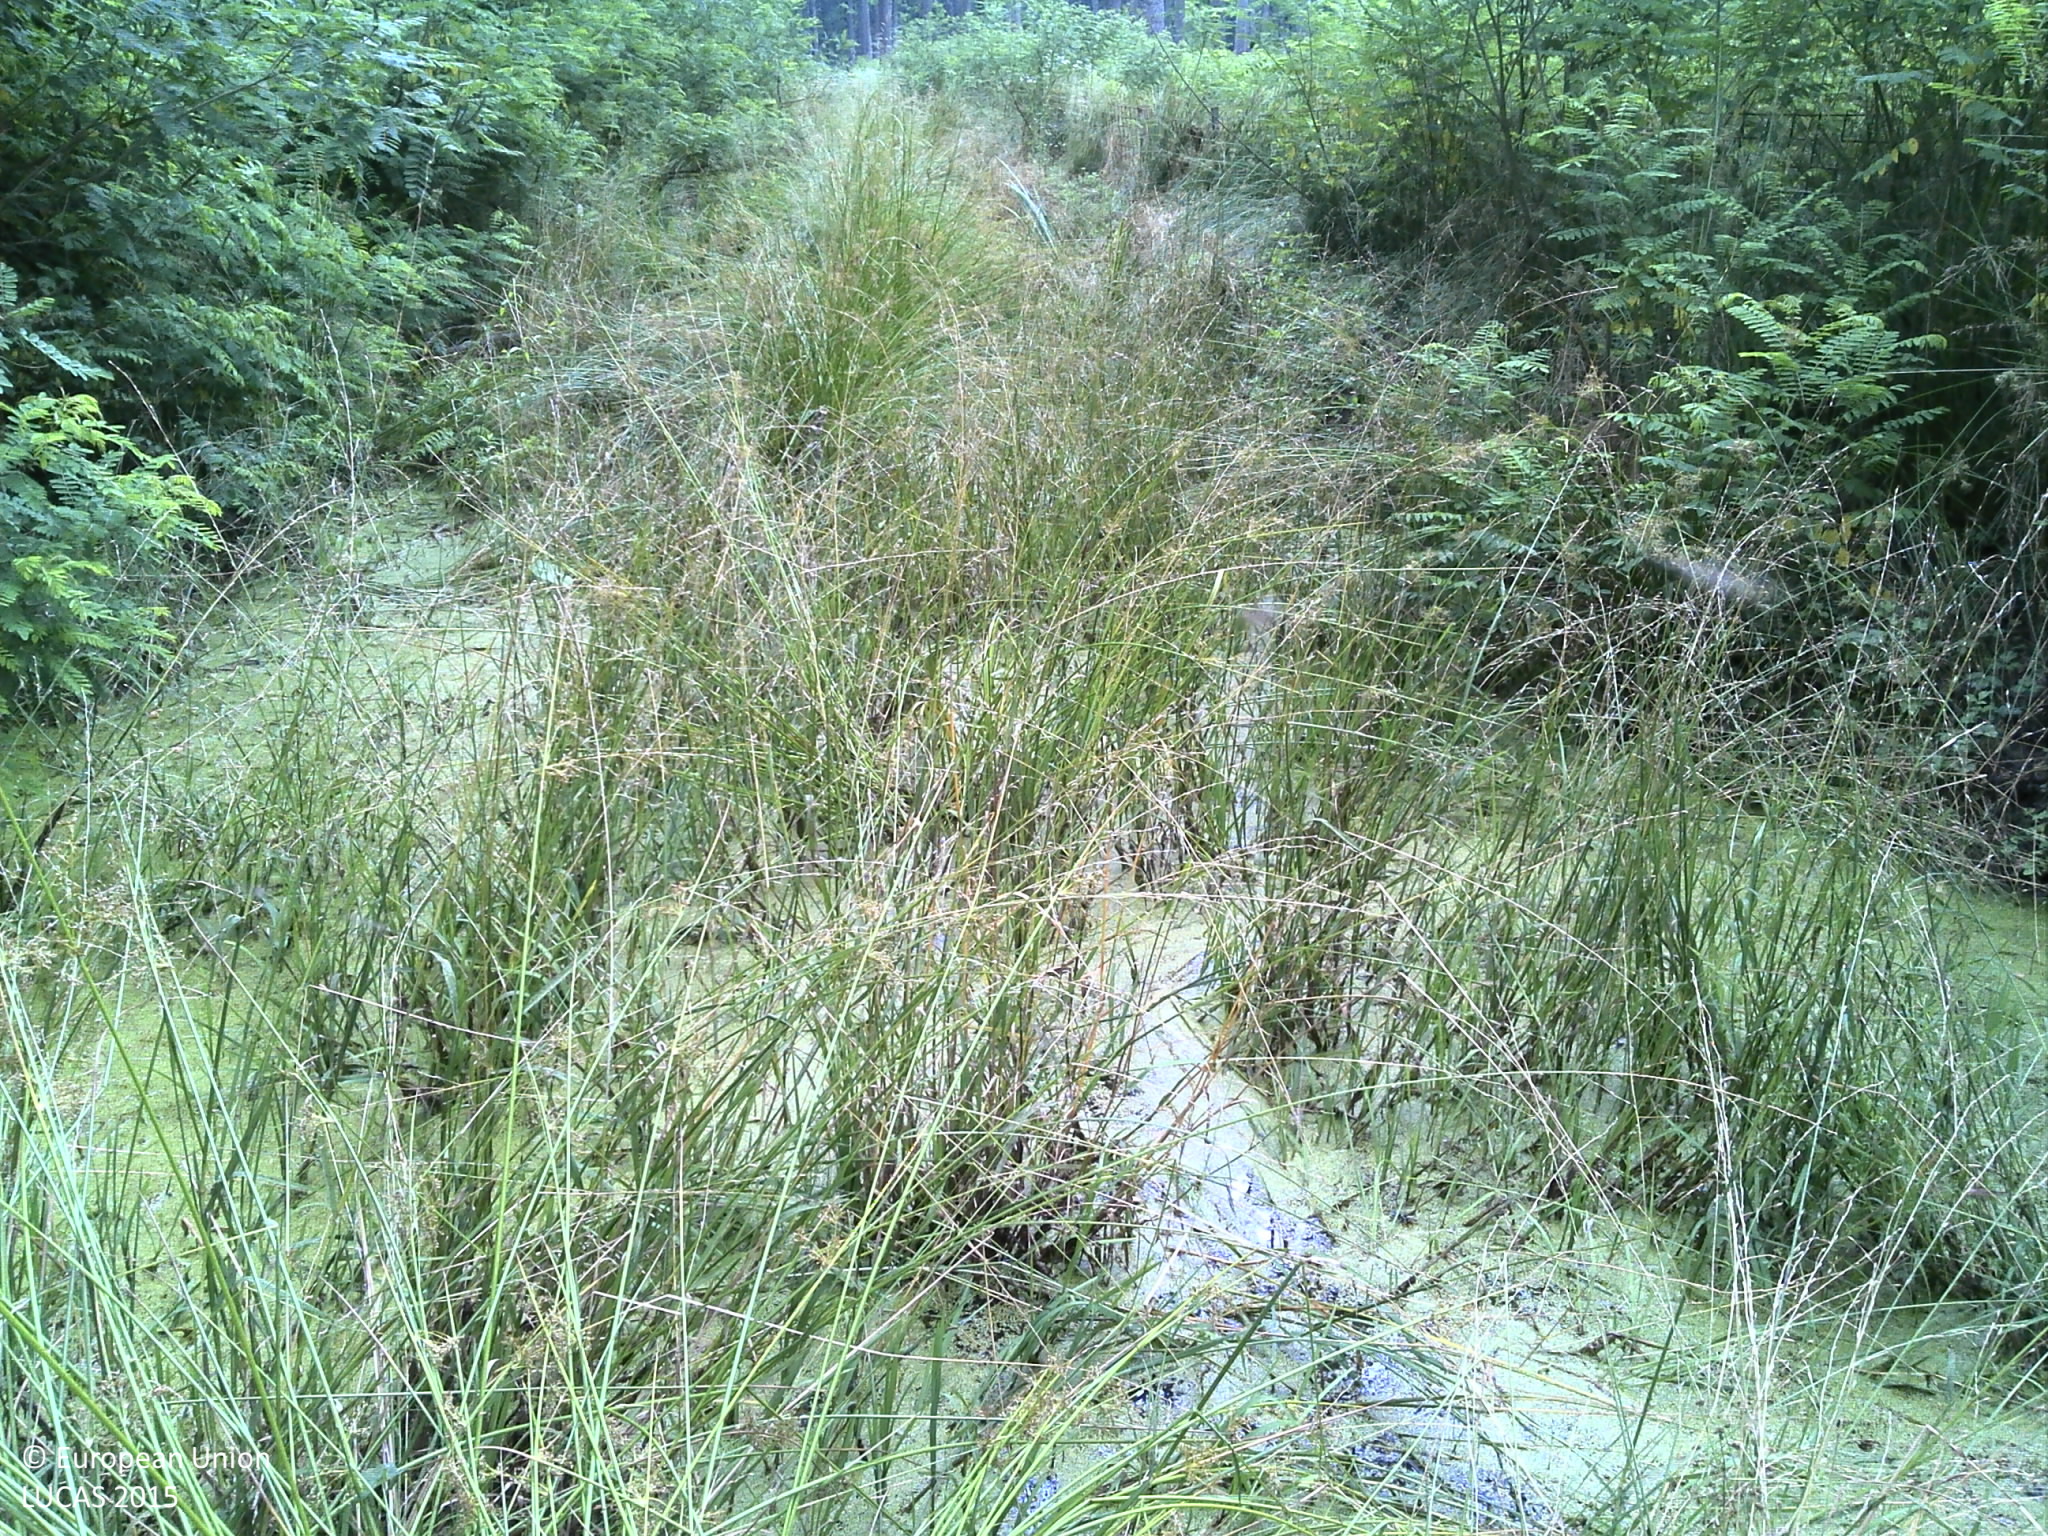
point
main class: Woodland
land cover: Broadleaved woodland
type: acidophilous oak and oak-birch forest
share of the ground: > 75 %
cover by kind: broadleaved forest trees 100 %
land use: Forestry
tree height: > 5 m
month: June
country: HR
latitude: 45.1745
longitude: 17.3673
